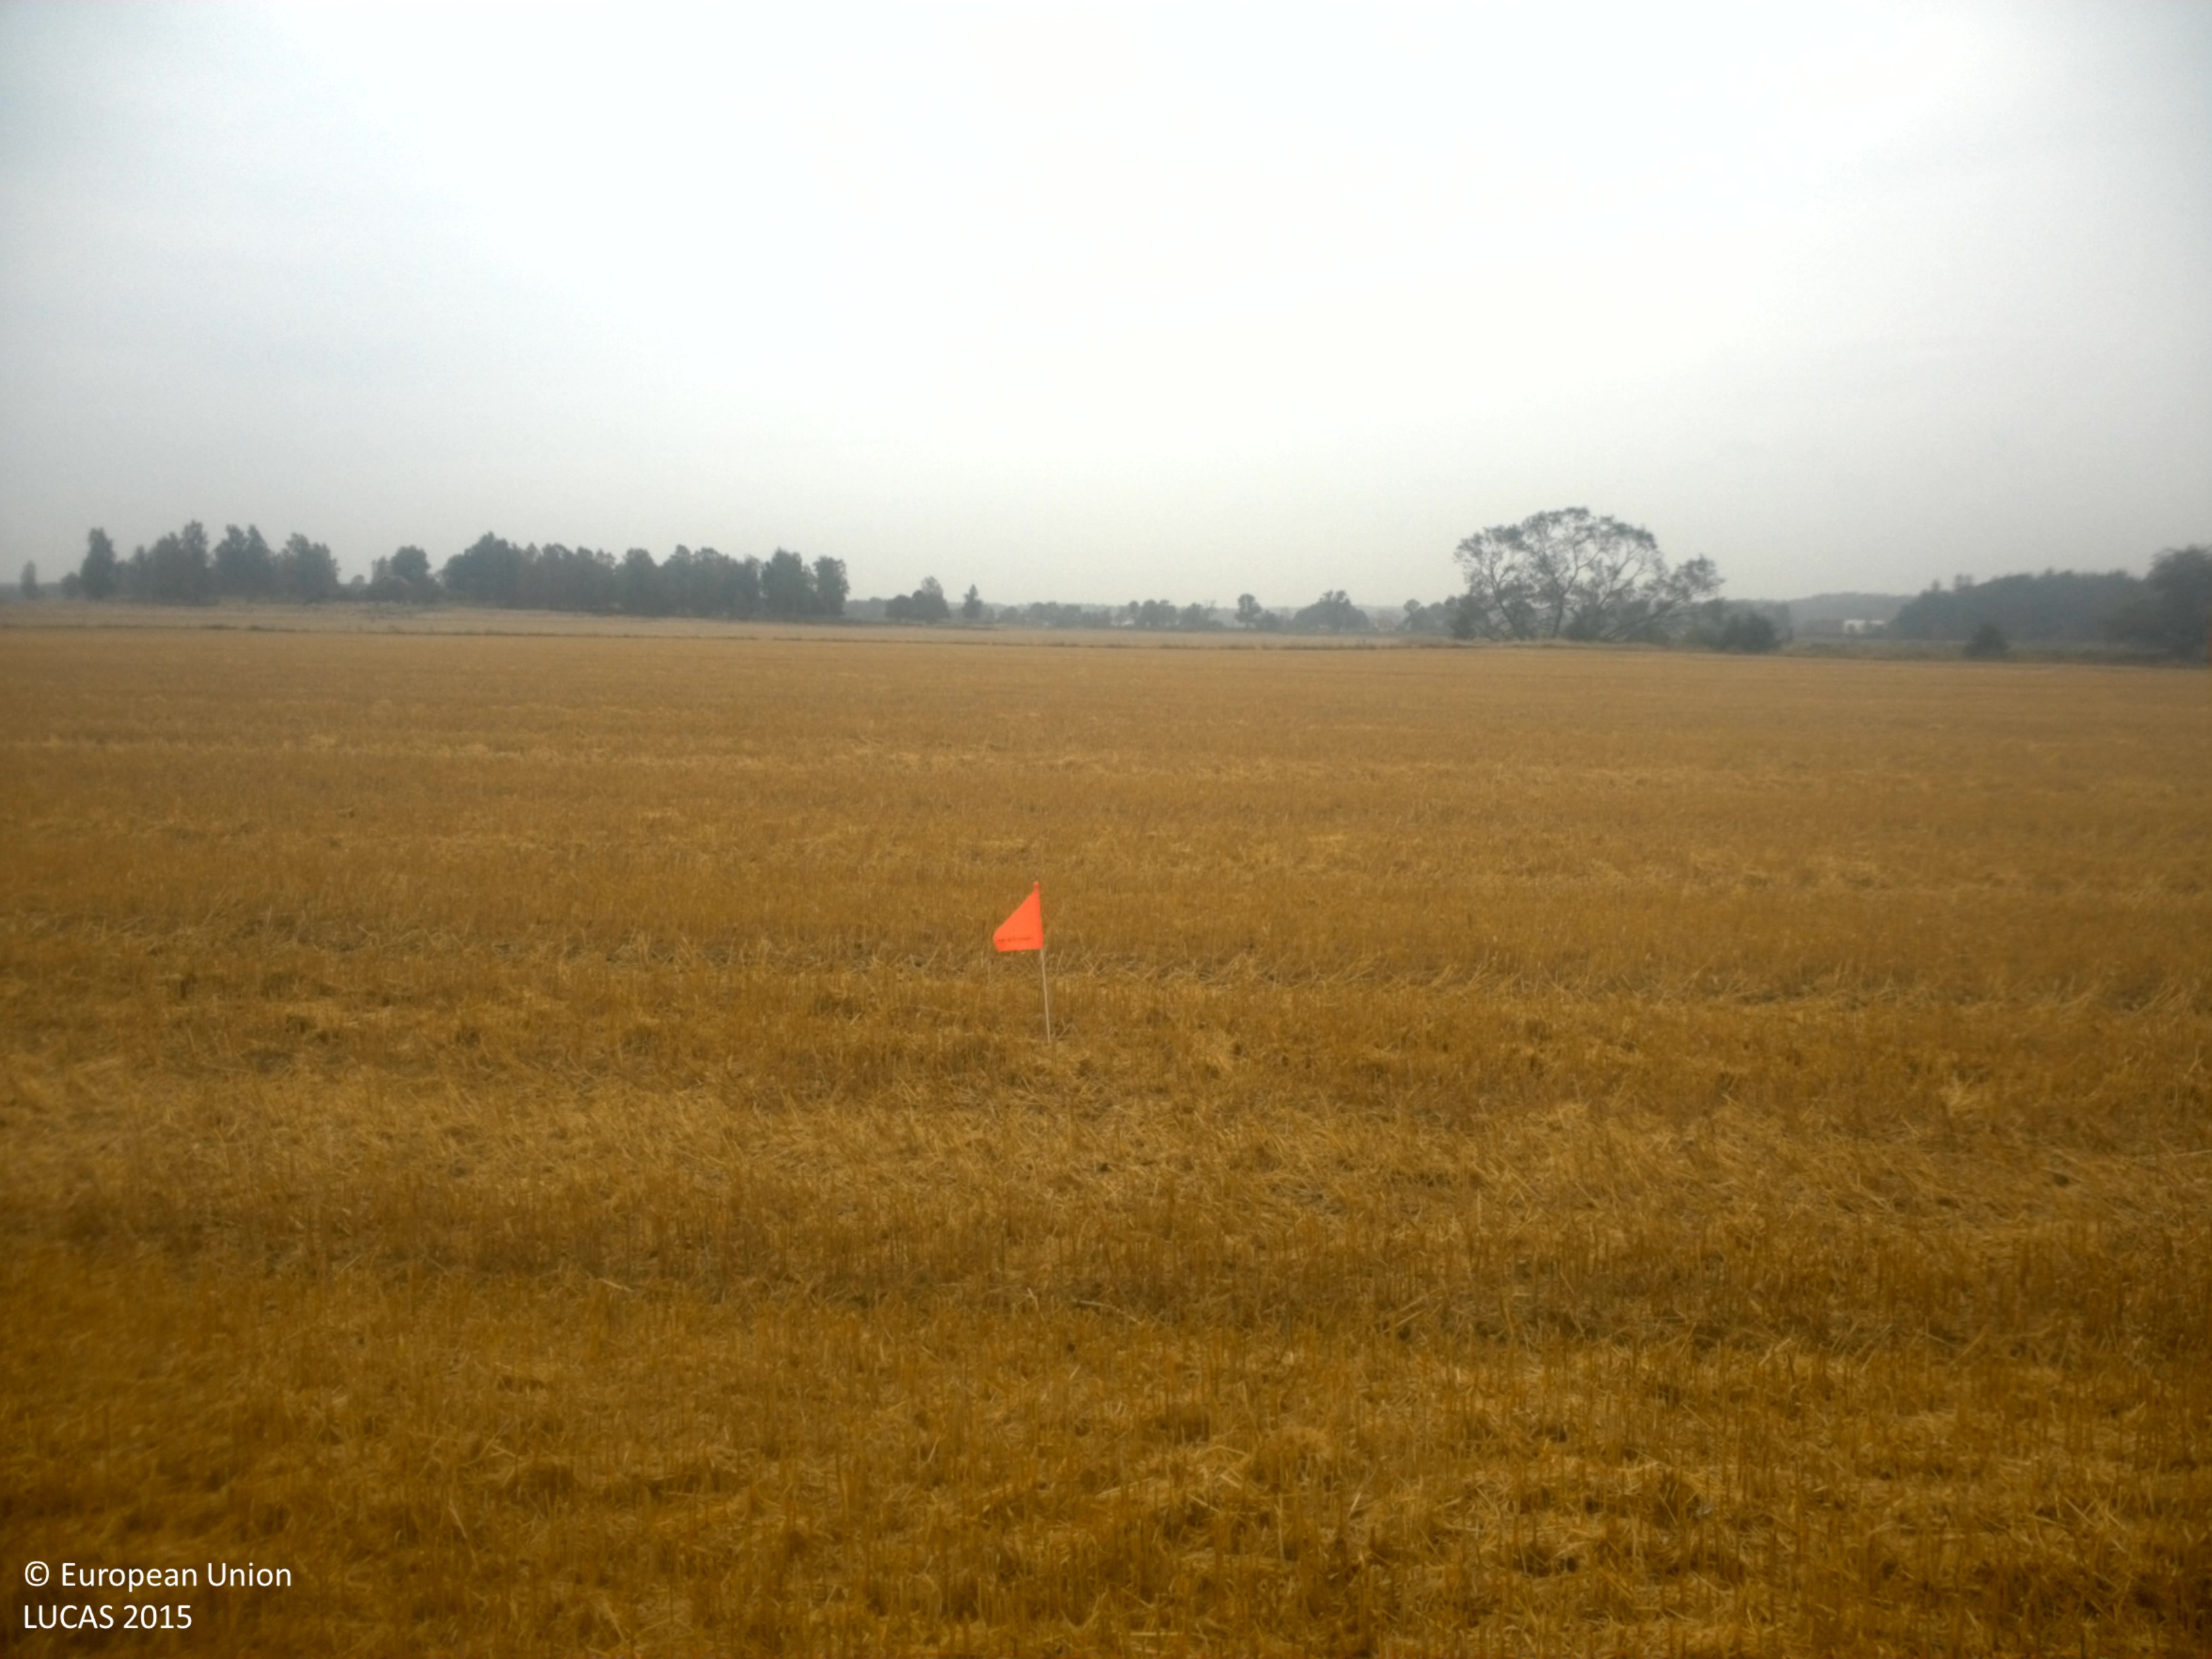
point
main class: Cropland
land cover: Oats
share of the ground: 50 - 75 %
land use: Agriculture (excluding fallow land and kitchen gardens)
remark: Harvested field
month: September
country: SE
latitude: 58.8077
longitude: 14.0263
